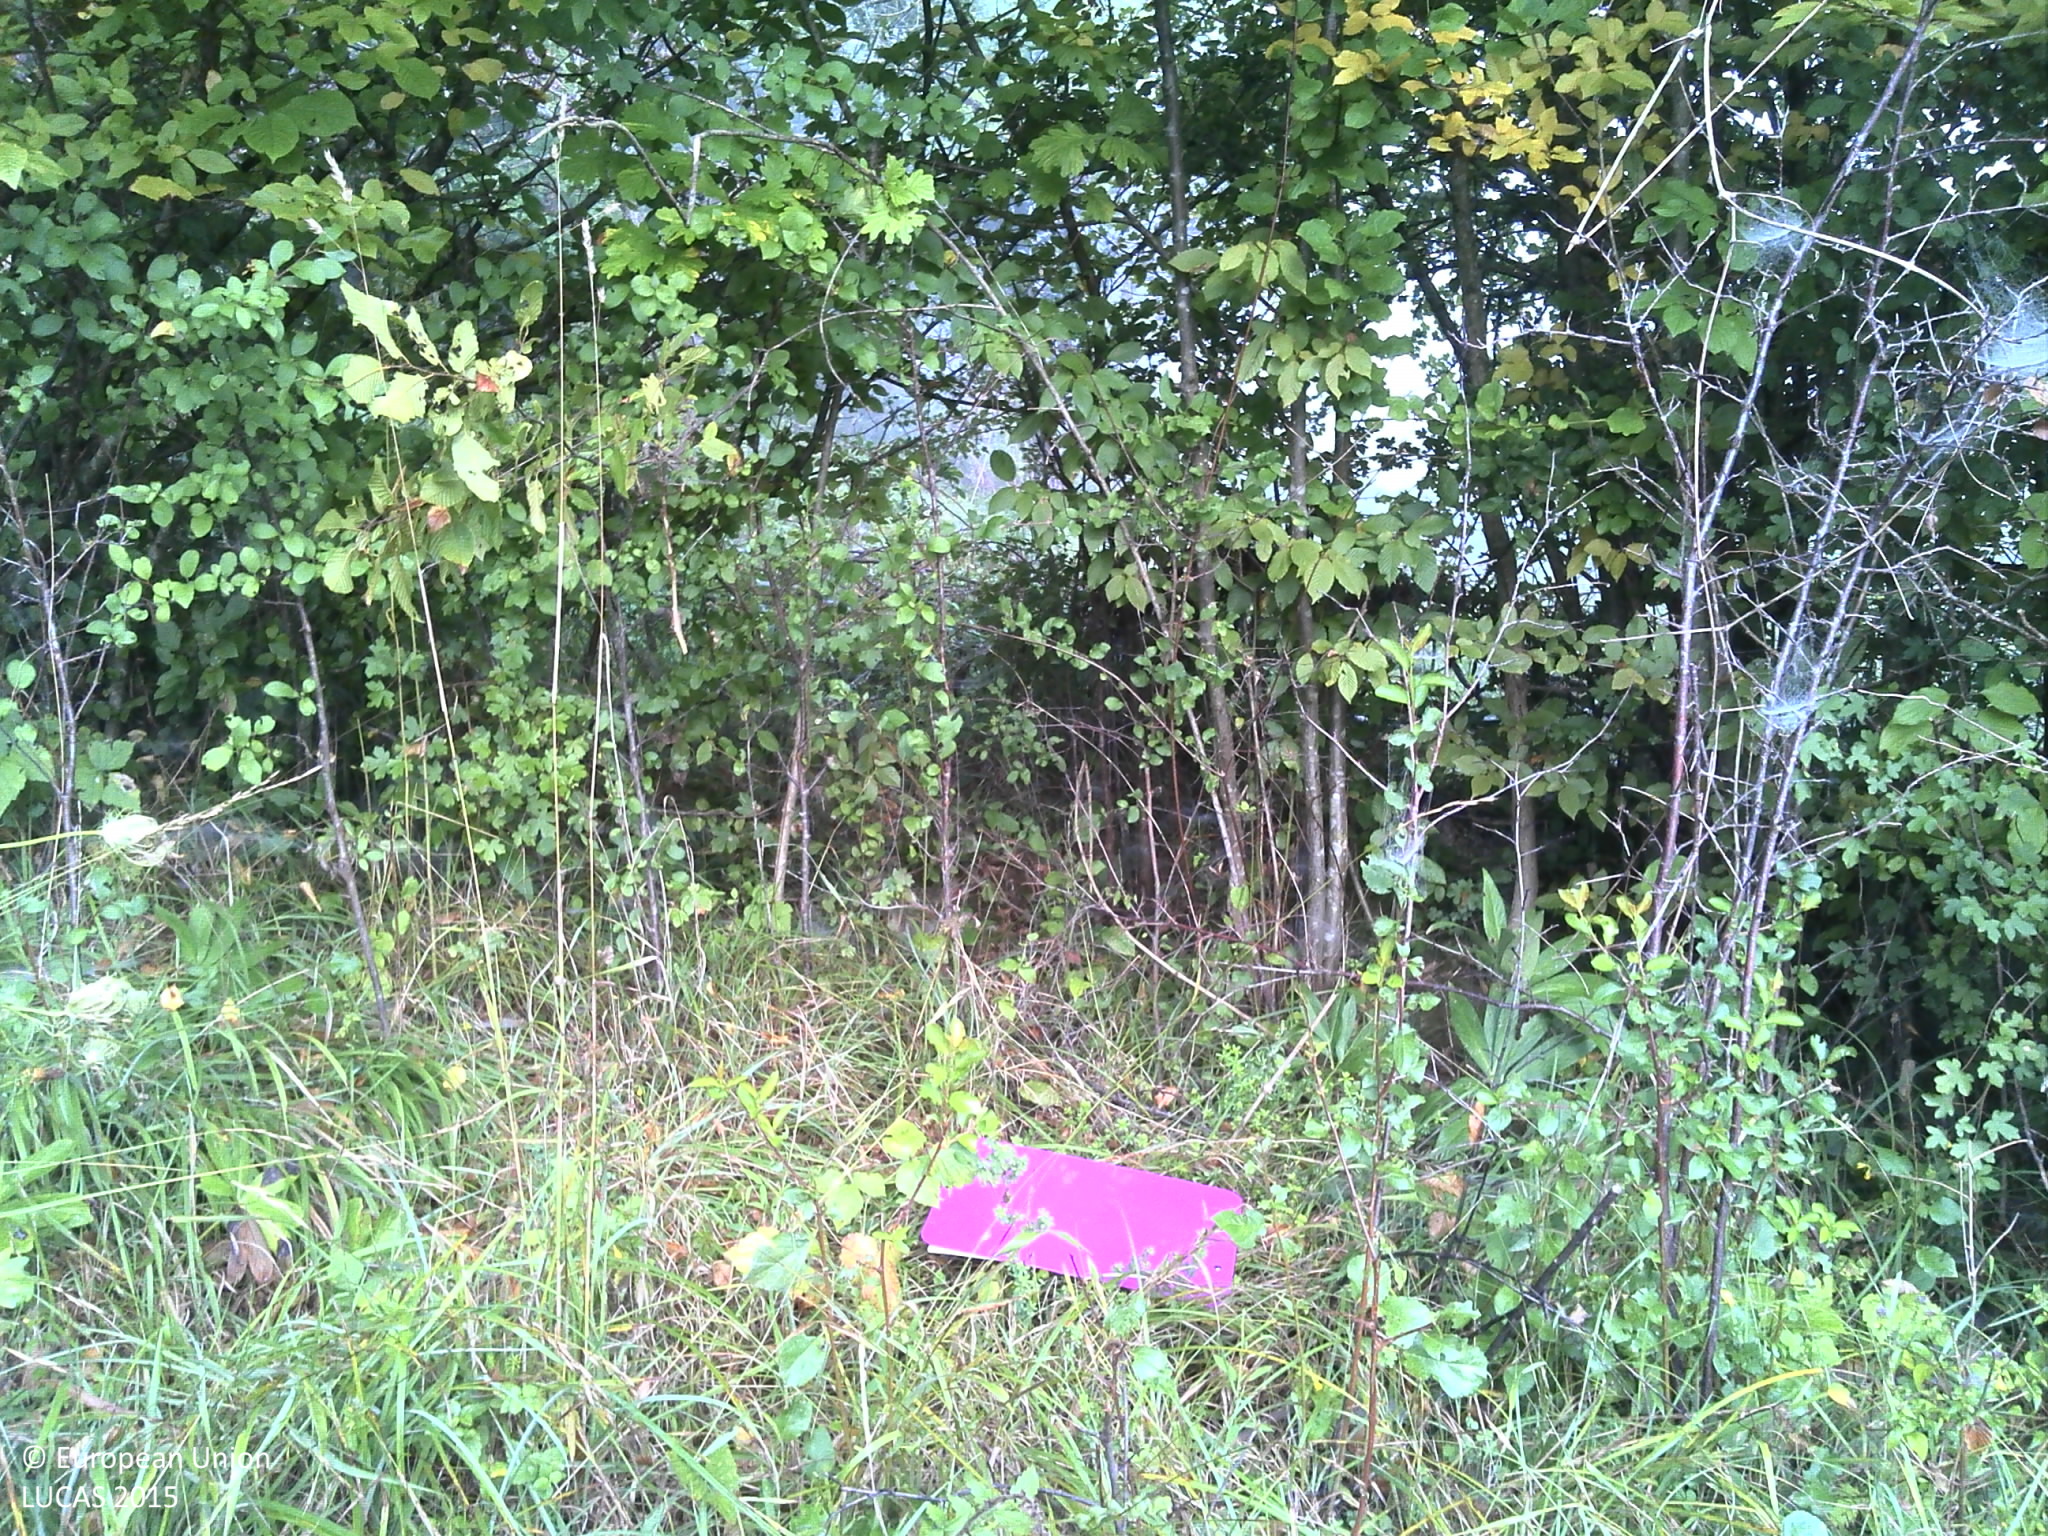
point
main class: Grassland
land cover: Spontaneously vegetated surfaces
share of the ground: > 75 %
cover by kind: herbaceous plants 95 %, shrubs 5 %
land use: Semi-natural and natural areas not in use
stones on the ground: < 10 %
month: August
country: HR
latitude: 45.1689
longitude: 16.3457
